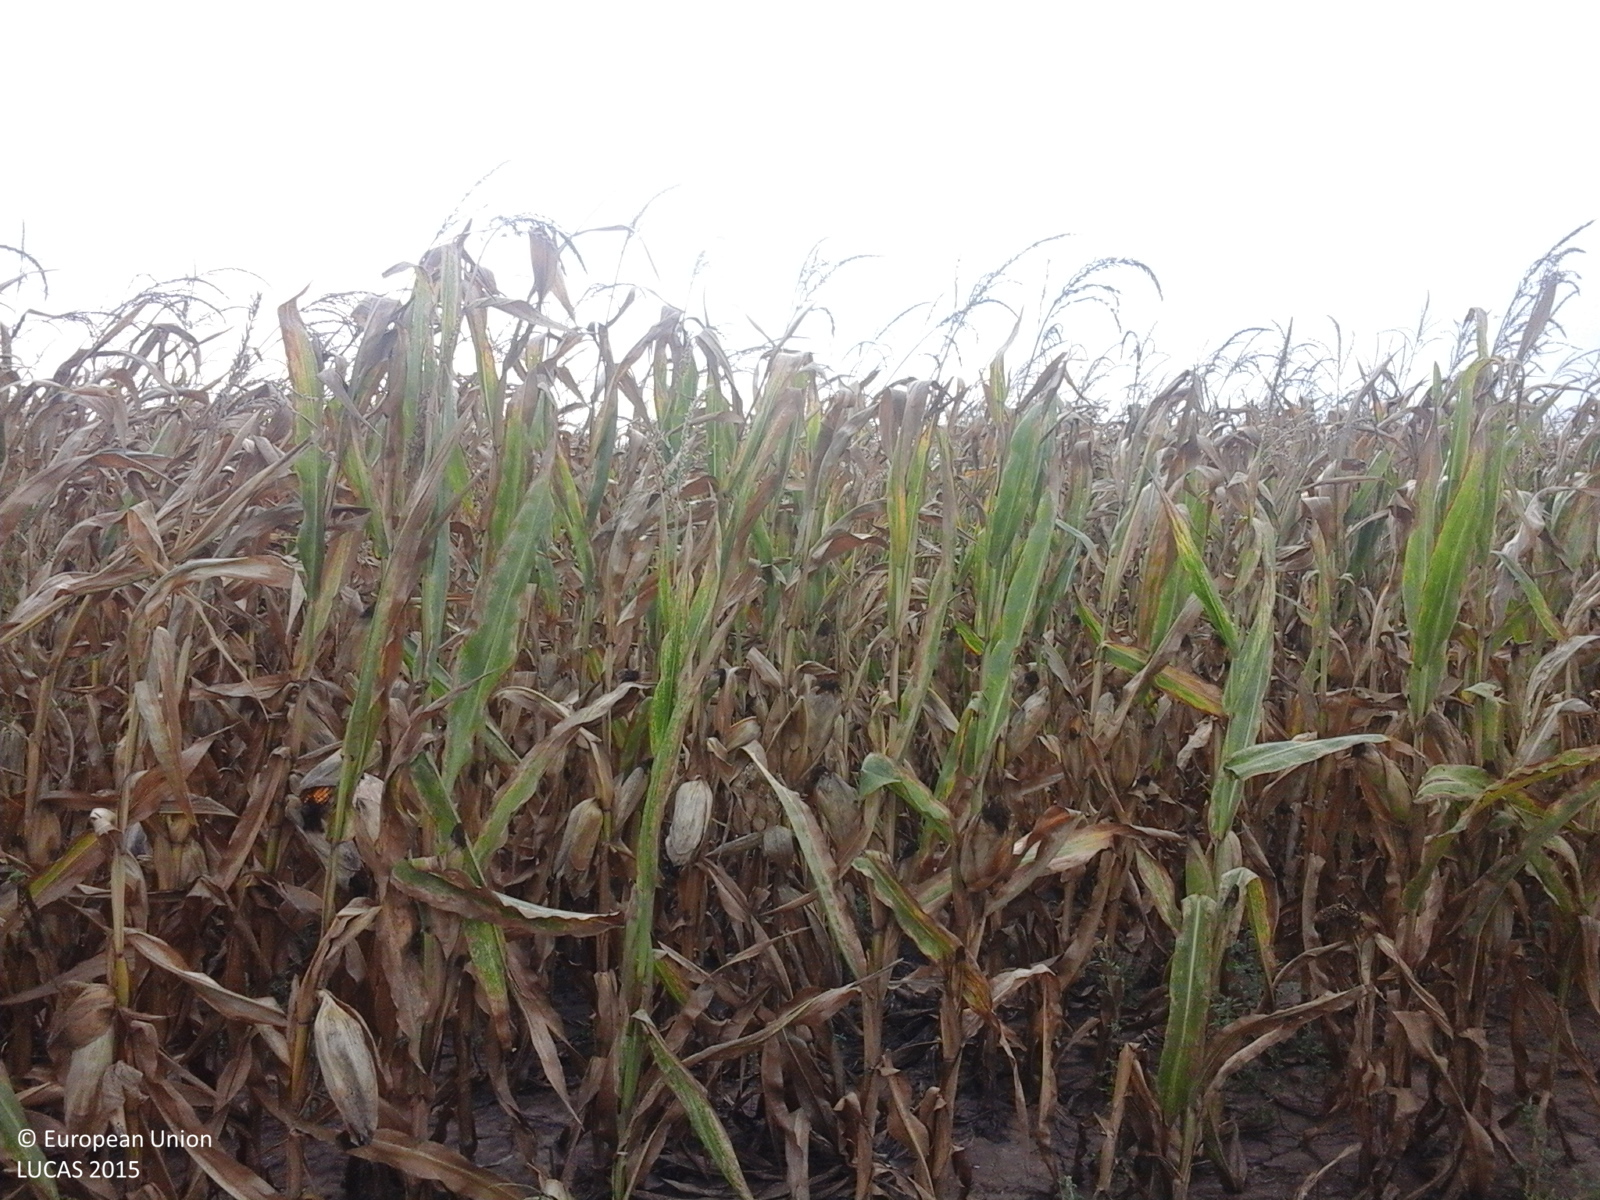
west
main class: Cropland
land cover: Maize
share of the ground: > 75 %
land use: Agriculture (excluding fallow land and kitchen gardens)
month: August
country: RO
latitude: 46.3023
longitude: 21.2382
